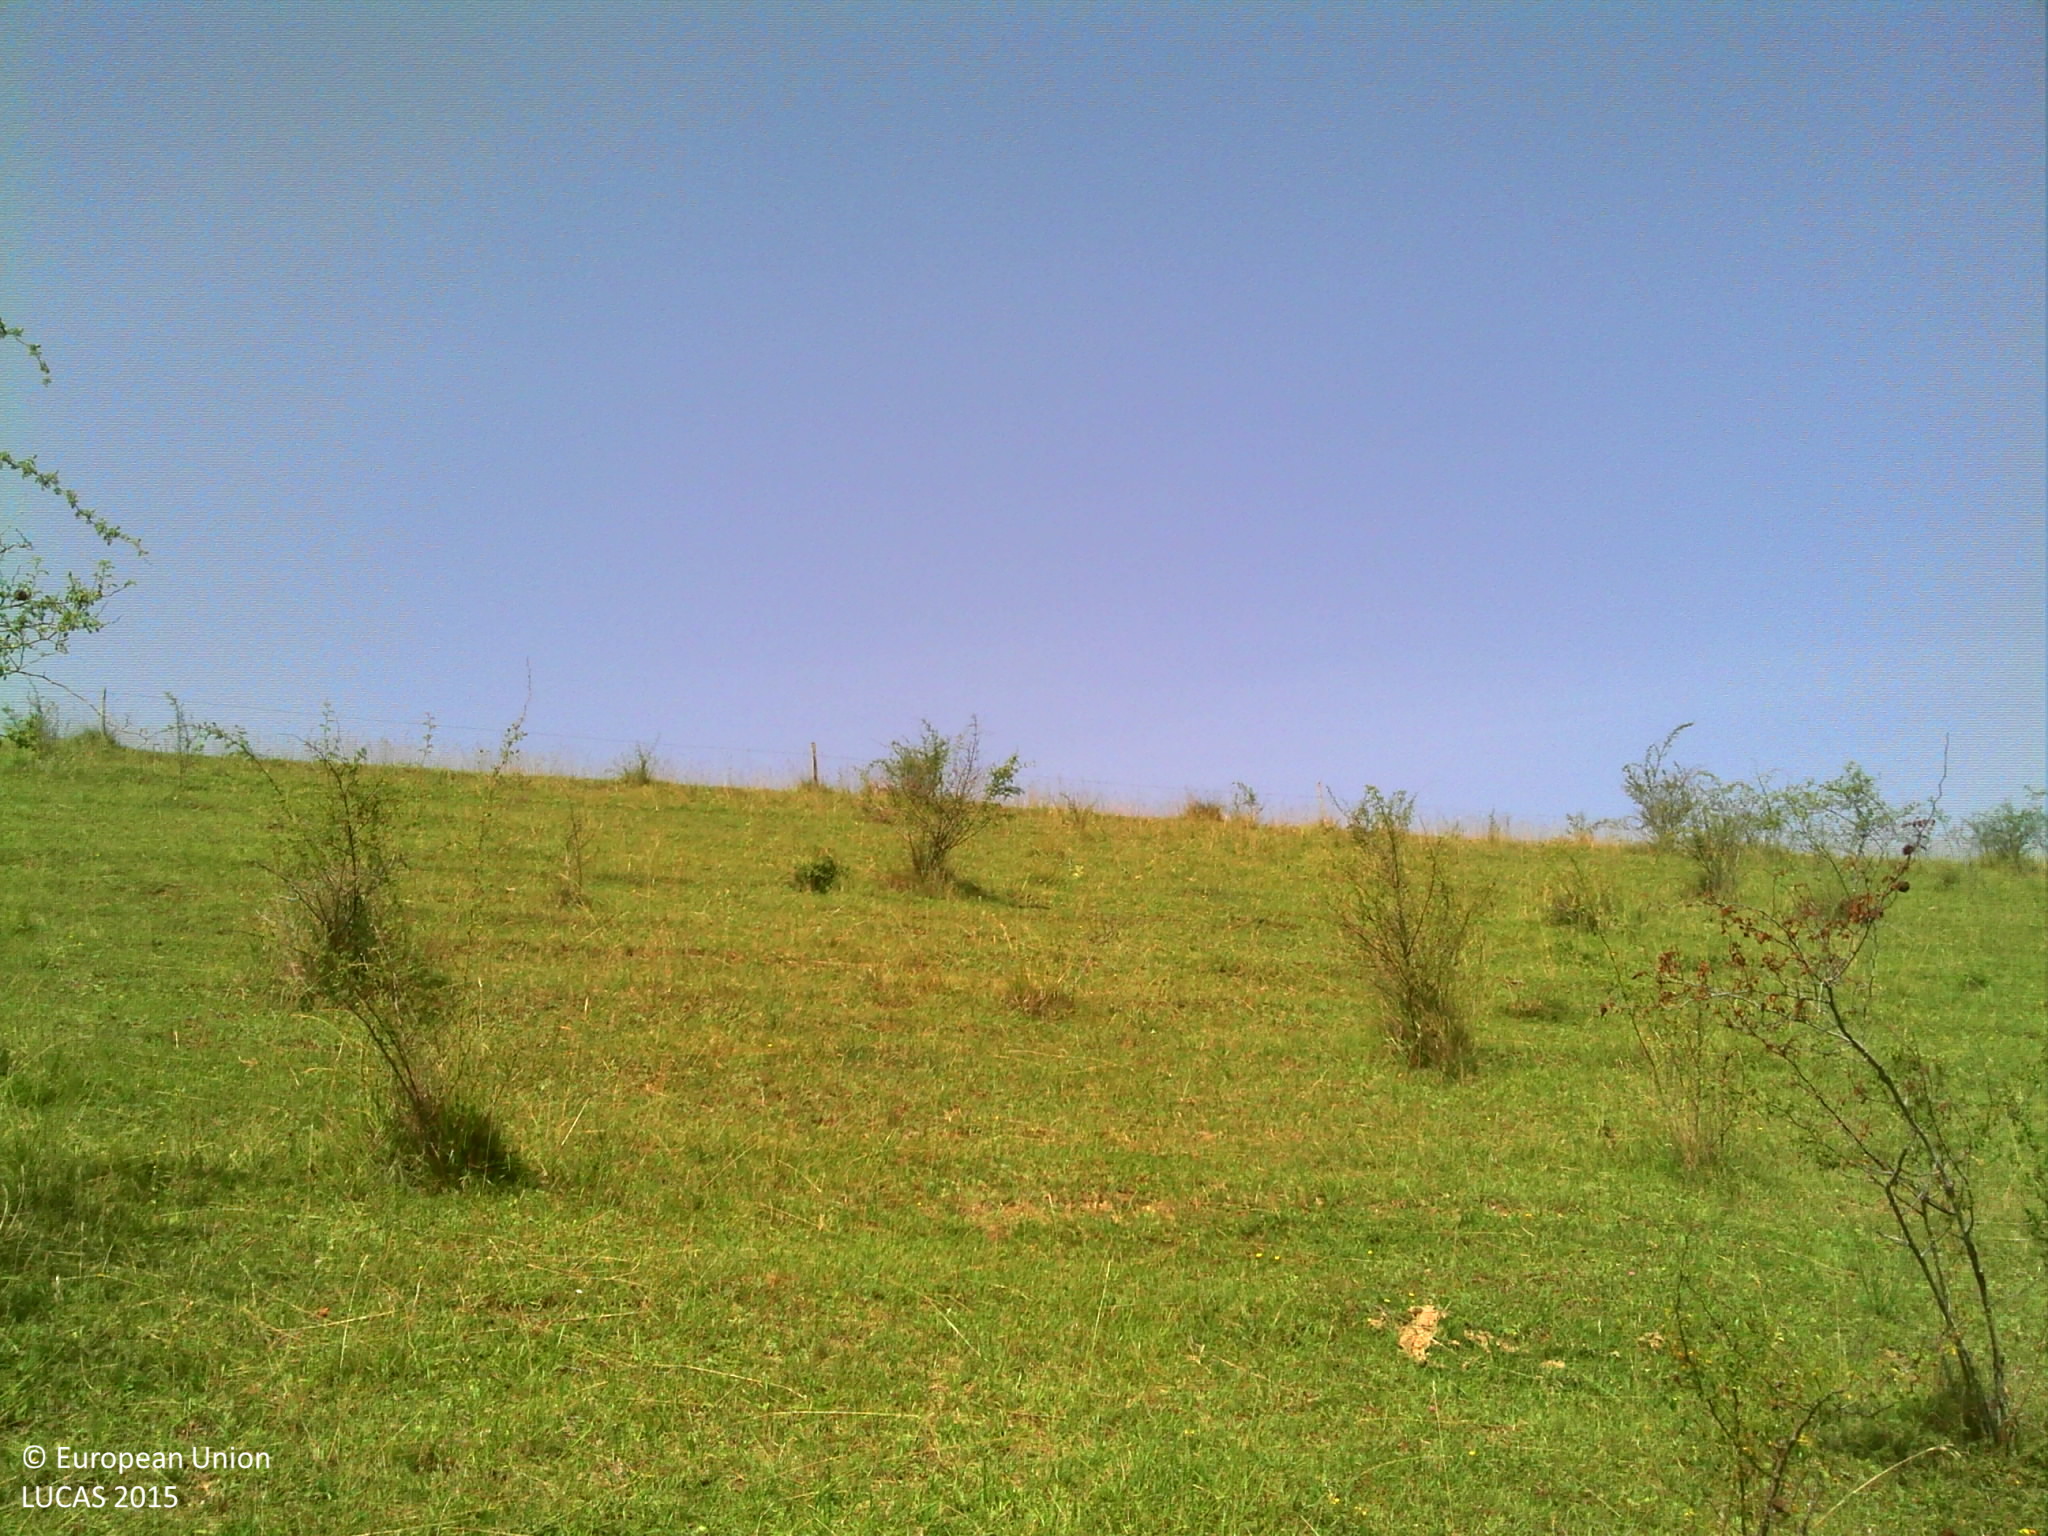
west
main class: Shrubland
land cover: Shrubland without tree cover
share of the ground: > 75 %
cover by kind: herbaceous plants 90 %, shrubs 10 %
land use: Agriculture (excluding fallow land and kitchen gardens)
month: July
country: FR
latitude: 43.1794
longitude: 1.4300
